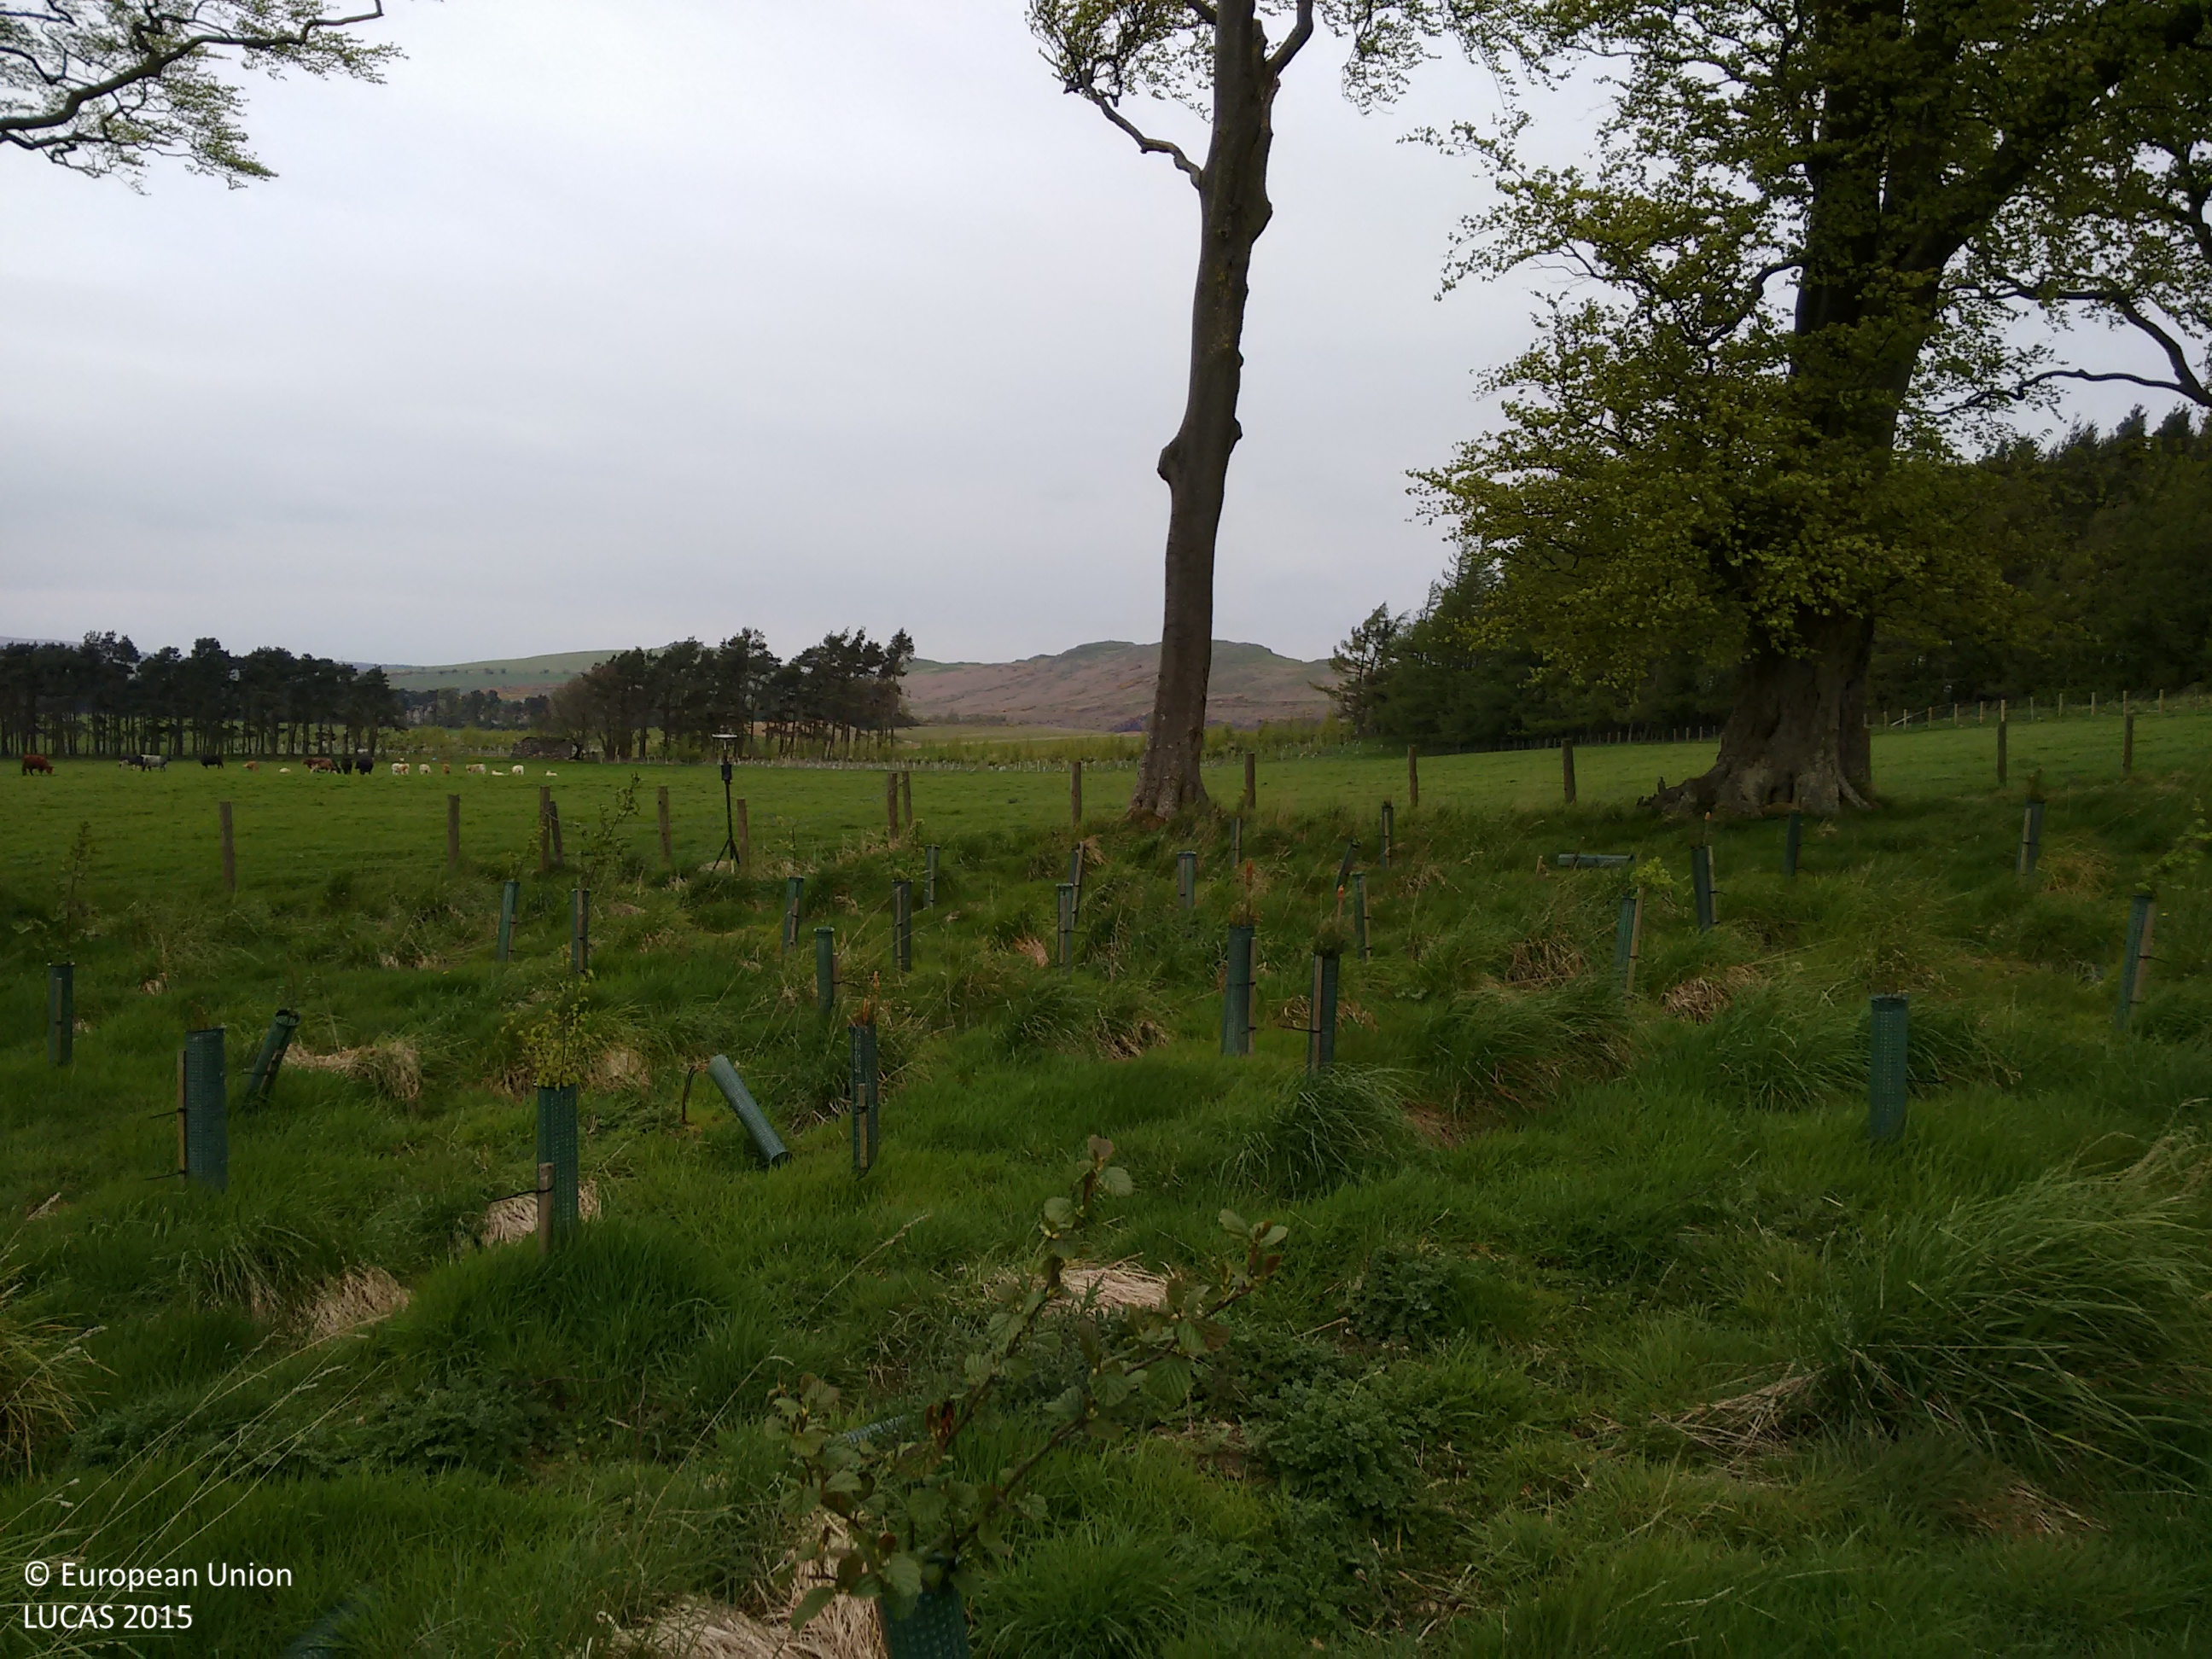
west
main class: Grassland
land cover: Grassland with sparse tree/shrub cover
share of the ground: > 75 %
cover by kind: herbaceous plants 90 %, broadleaved forest trees 5 %, shrubs 5 %
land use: Forestry
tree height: < 5 m
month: May
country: GB
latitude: 55.8864
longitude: -3.3608
